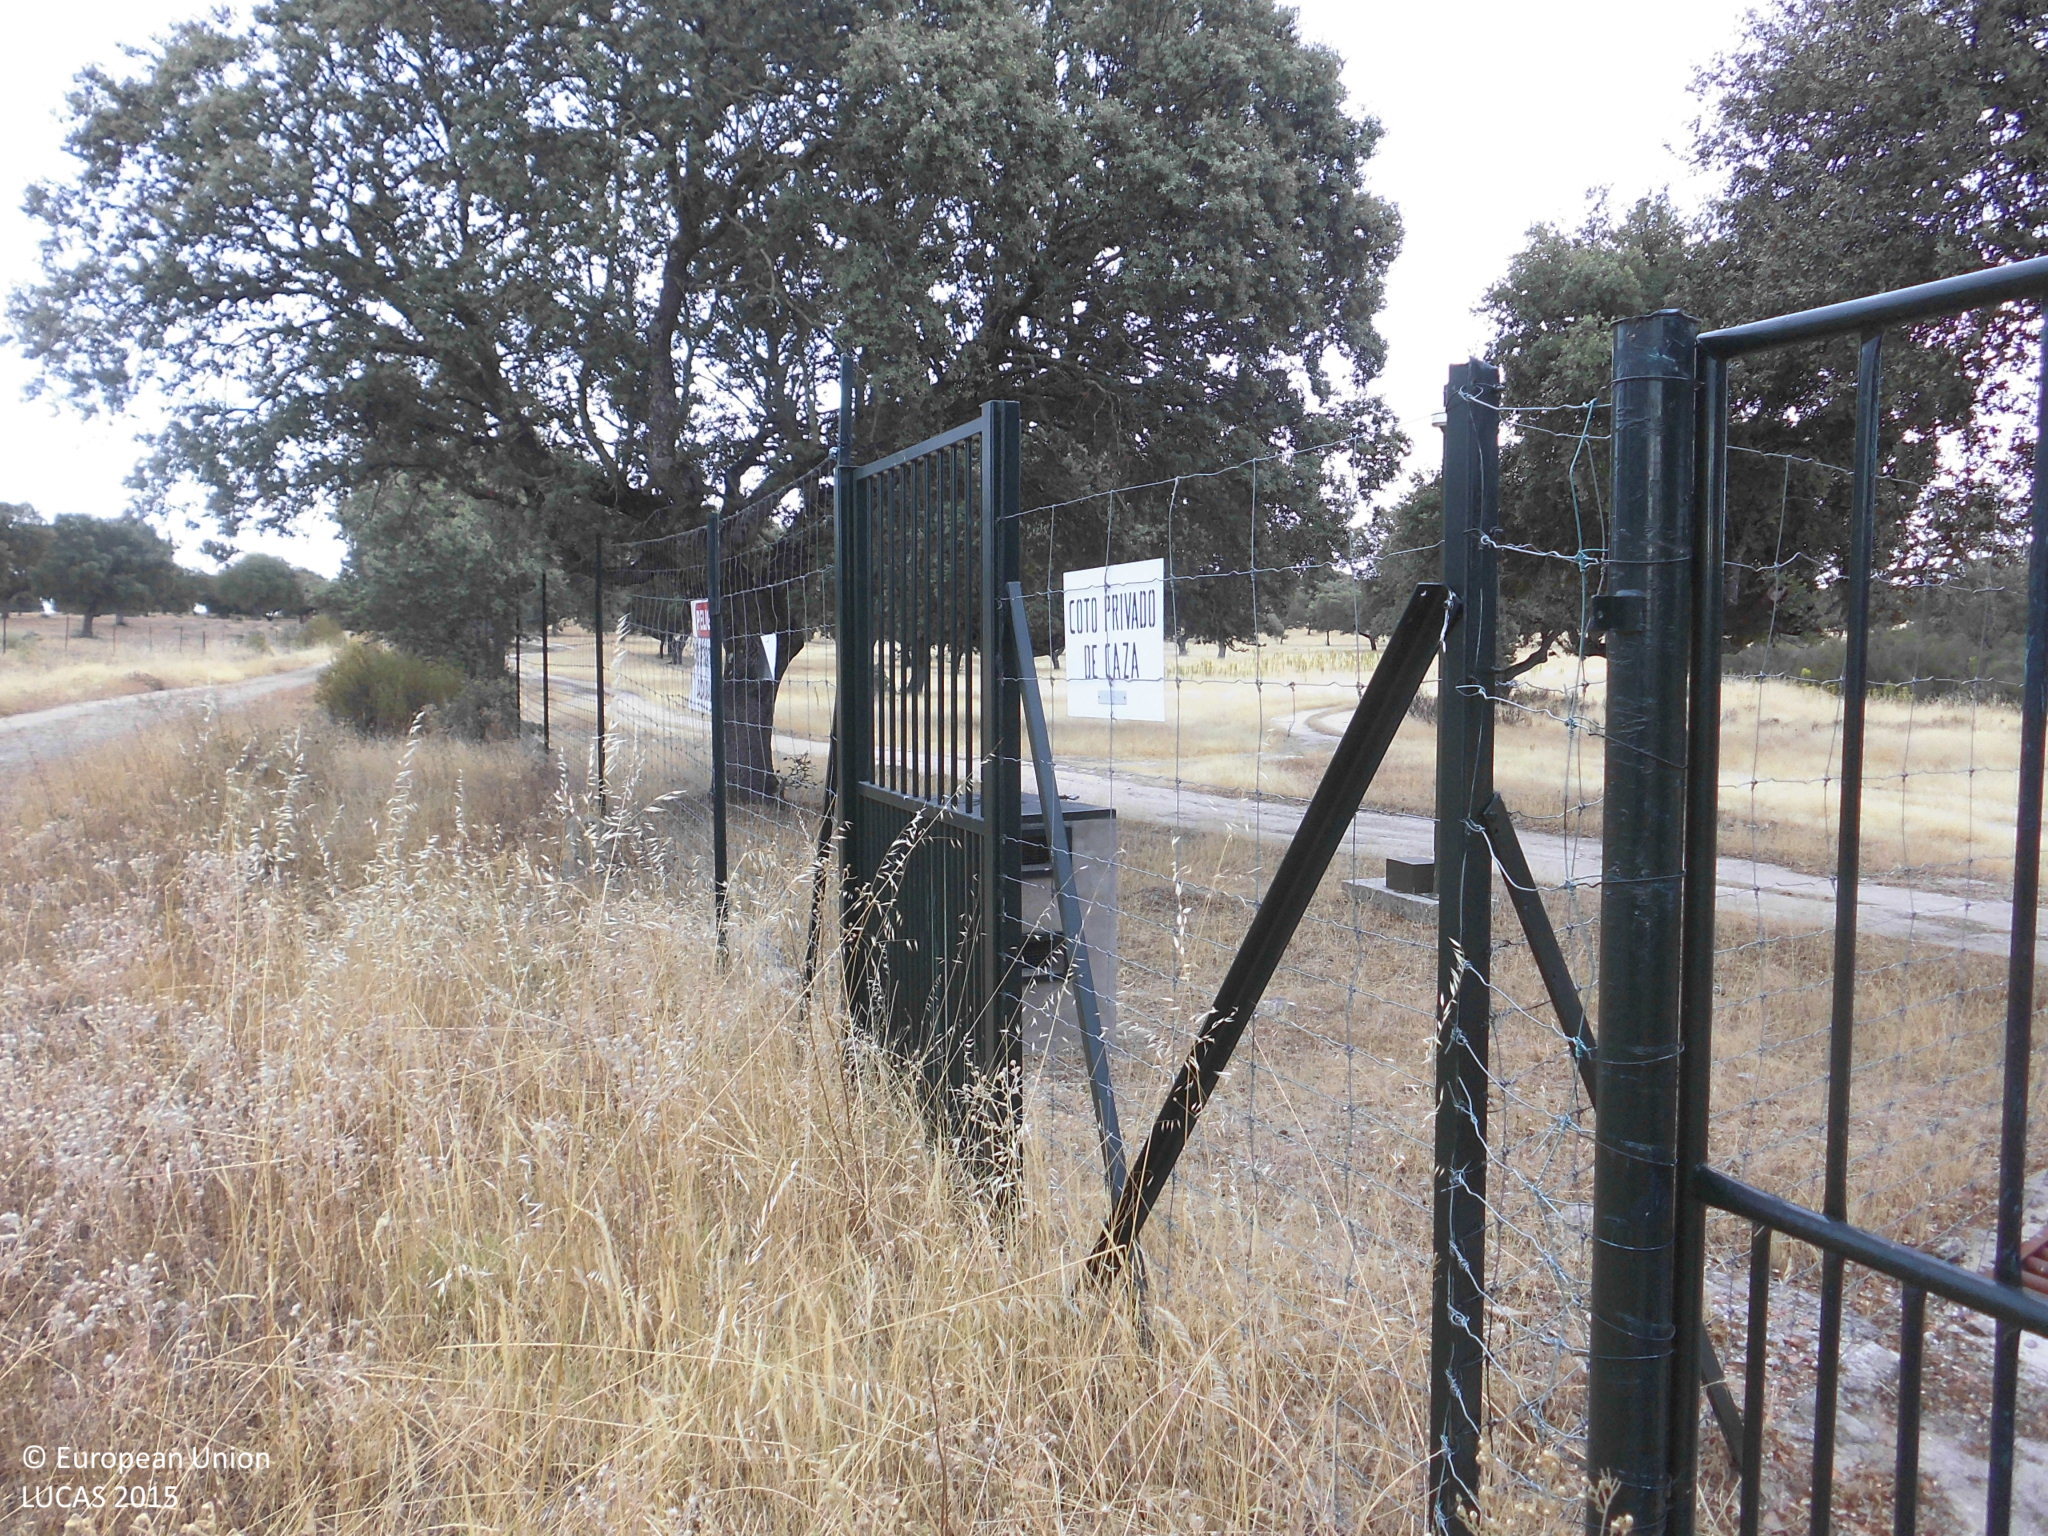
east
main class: Woodland
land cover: Broadleaved woodland
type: broadleaved evergreen forest
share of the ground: 25 - 50 %
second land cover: Grassland without tree/shrub cover
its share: > 75 %
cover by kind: herbaceous plants 55 %, broadleaved forest trees 45 %
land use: Forestry
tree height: > 5 m
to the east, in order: Broadleaved woodland; Grassland without tree/shrub cover; Broadleaved woodland; Rivers and streams; Broadleaved woodland; Tracks; Broadleaved woodland
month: July
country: ES
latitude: 39.8464
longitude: -6.5450
